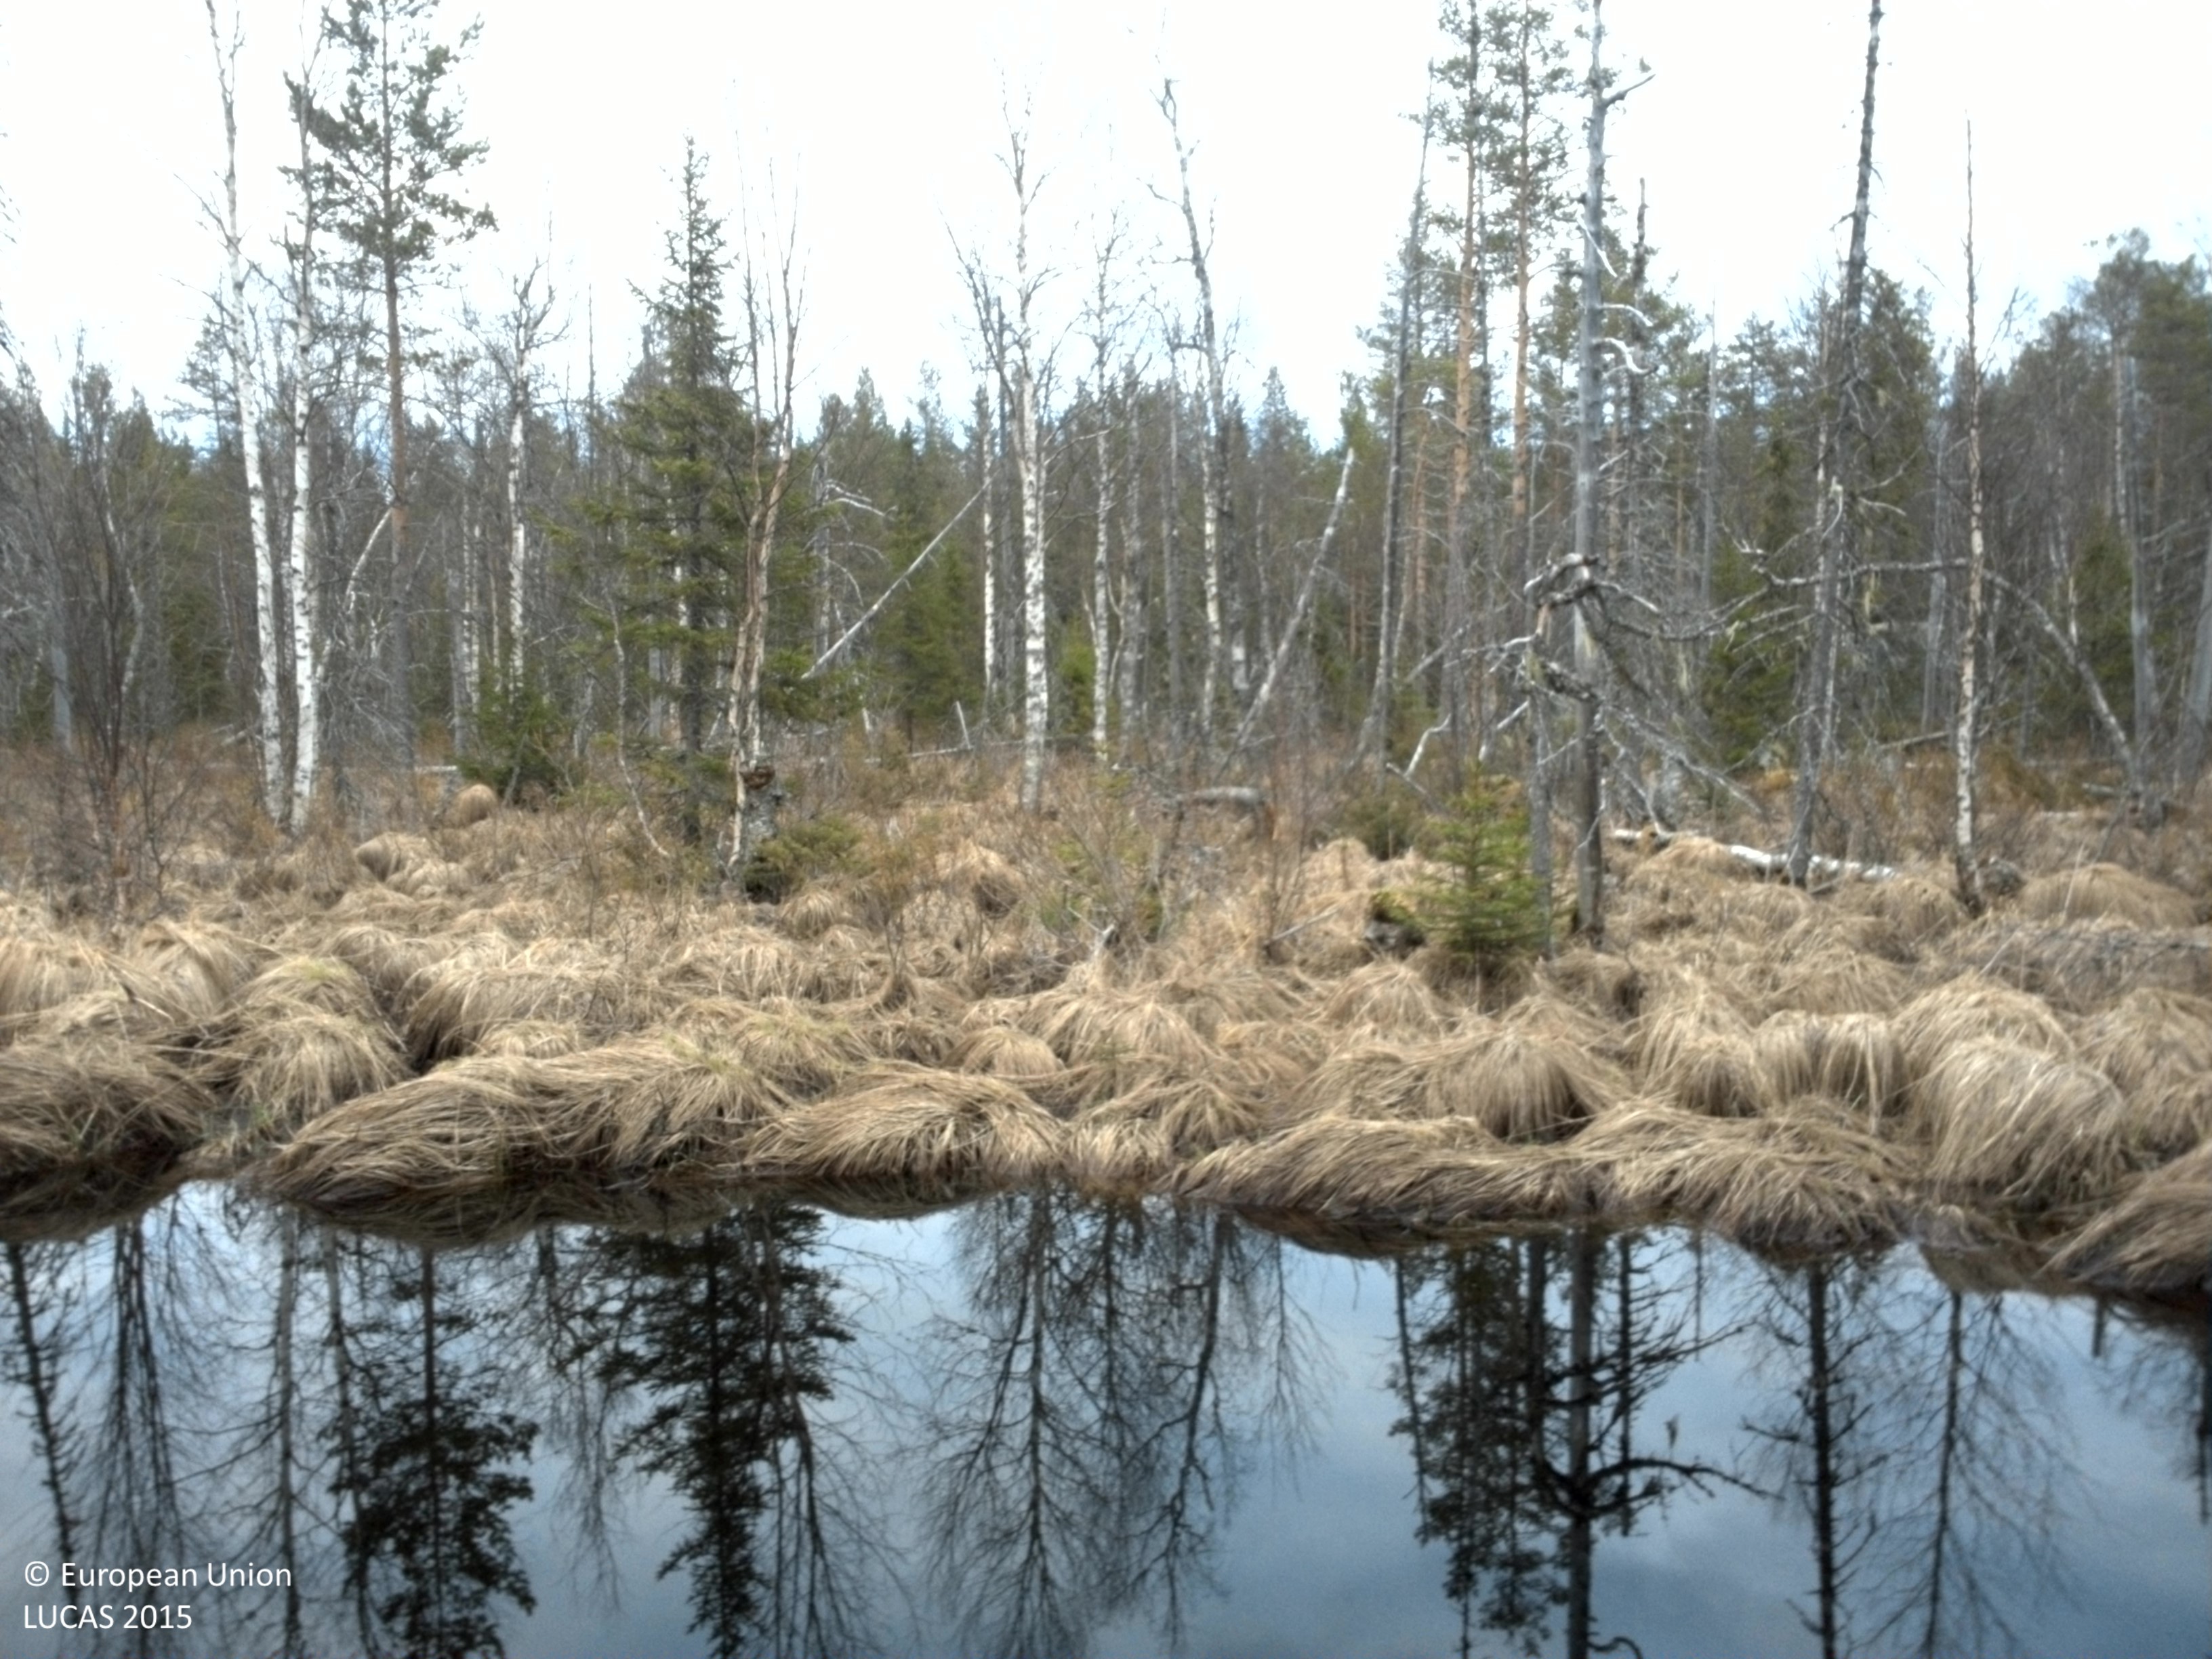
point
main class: Woodland
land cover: Broadleaved woodland
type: boreal forest
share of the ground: > 75 %
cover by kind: broadleaved forest trees 70 %, herbaceous plants 20 %, coniferous forest trees 10 %
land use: Semi-natural and natural areas not in use
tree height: > 5 m
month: May
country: SE
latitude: 62.6752
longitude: 14.9593
